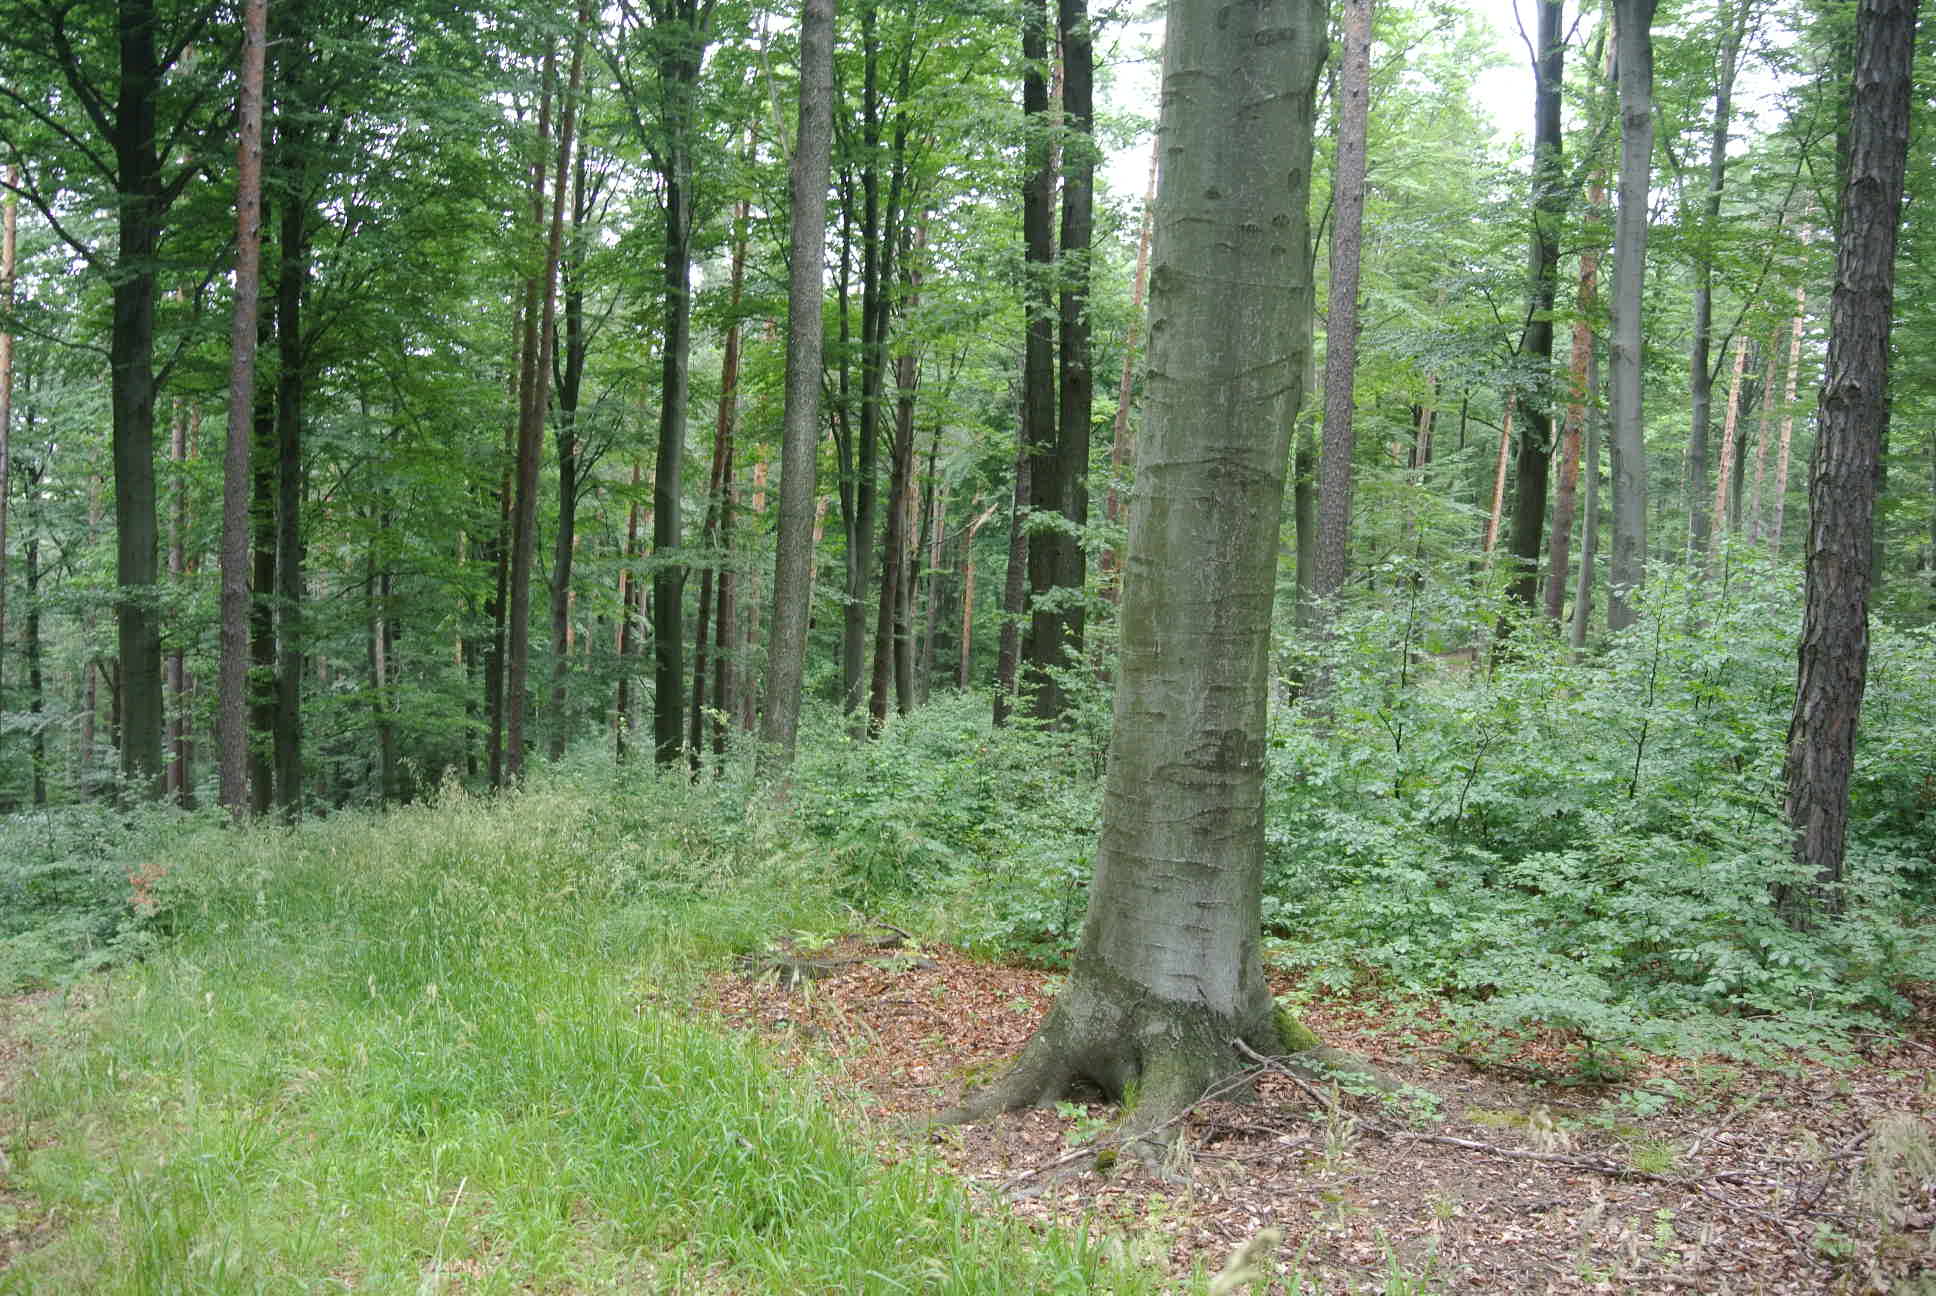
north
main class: Woodland
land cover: Pine dominated mixed woodland
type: alpine coniferous forest
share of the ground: > 75 %
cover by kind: broadleaved forest trees 45 %, coniferous forest trees 35 %, herbaceous plants 20 %
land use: Forestry
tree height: > 5 m
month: July
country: AT
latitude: 47.6400
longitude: 16.4062
